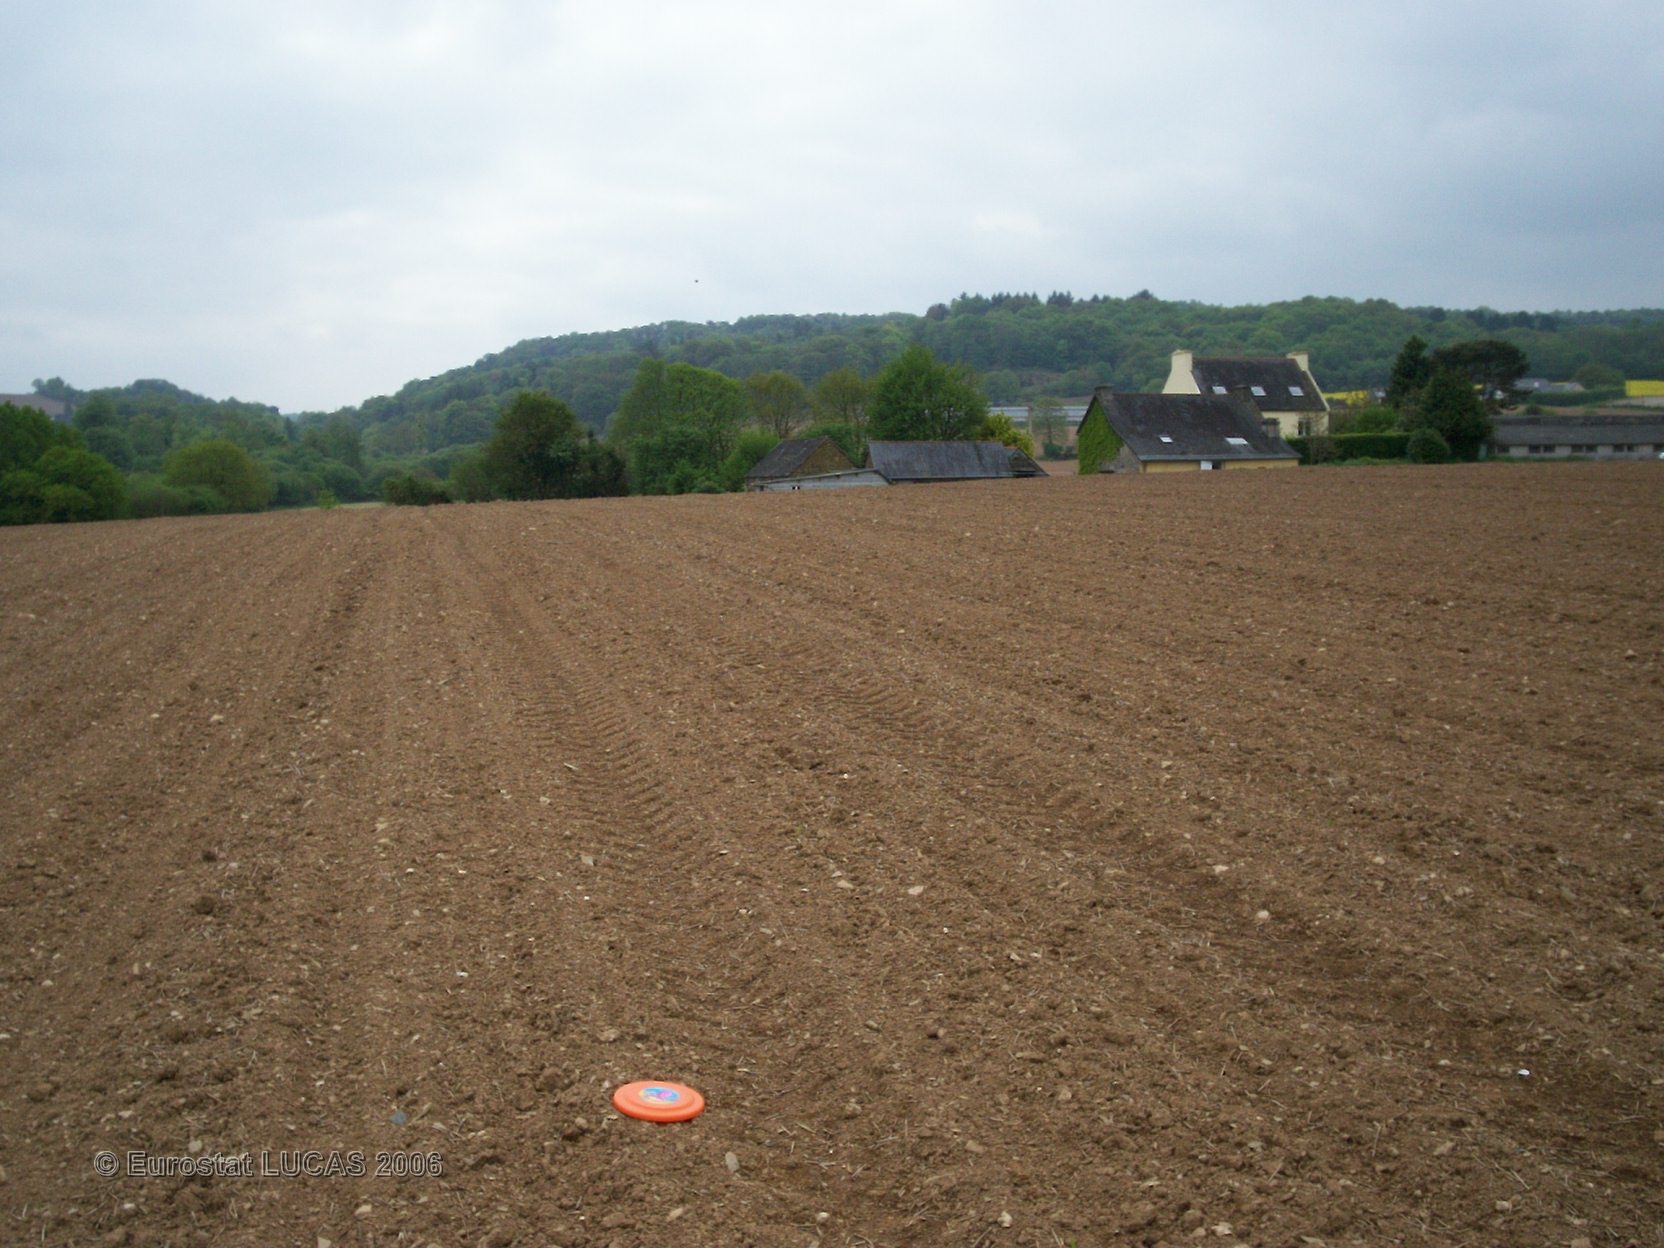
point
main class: Cropland
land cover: Maize
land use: Agriculture (excluding fallow land and kitchen gardens)
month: May
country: FR
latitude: 48.1710
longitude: -3.9500
